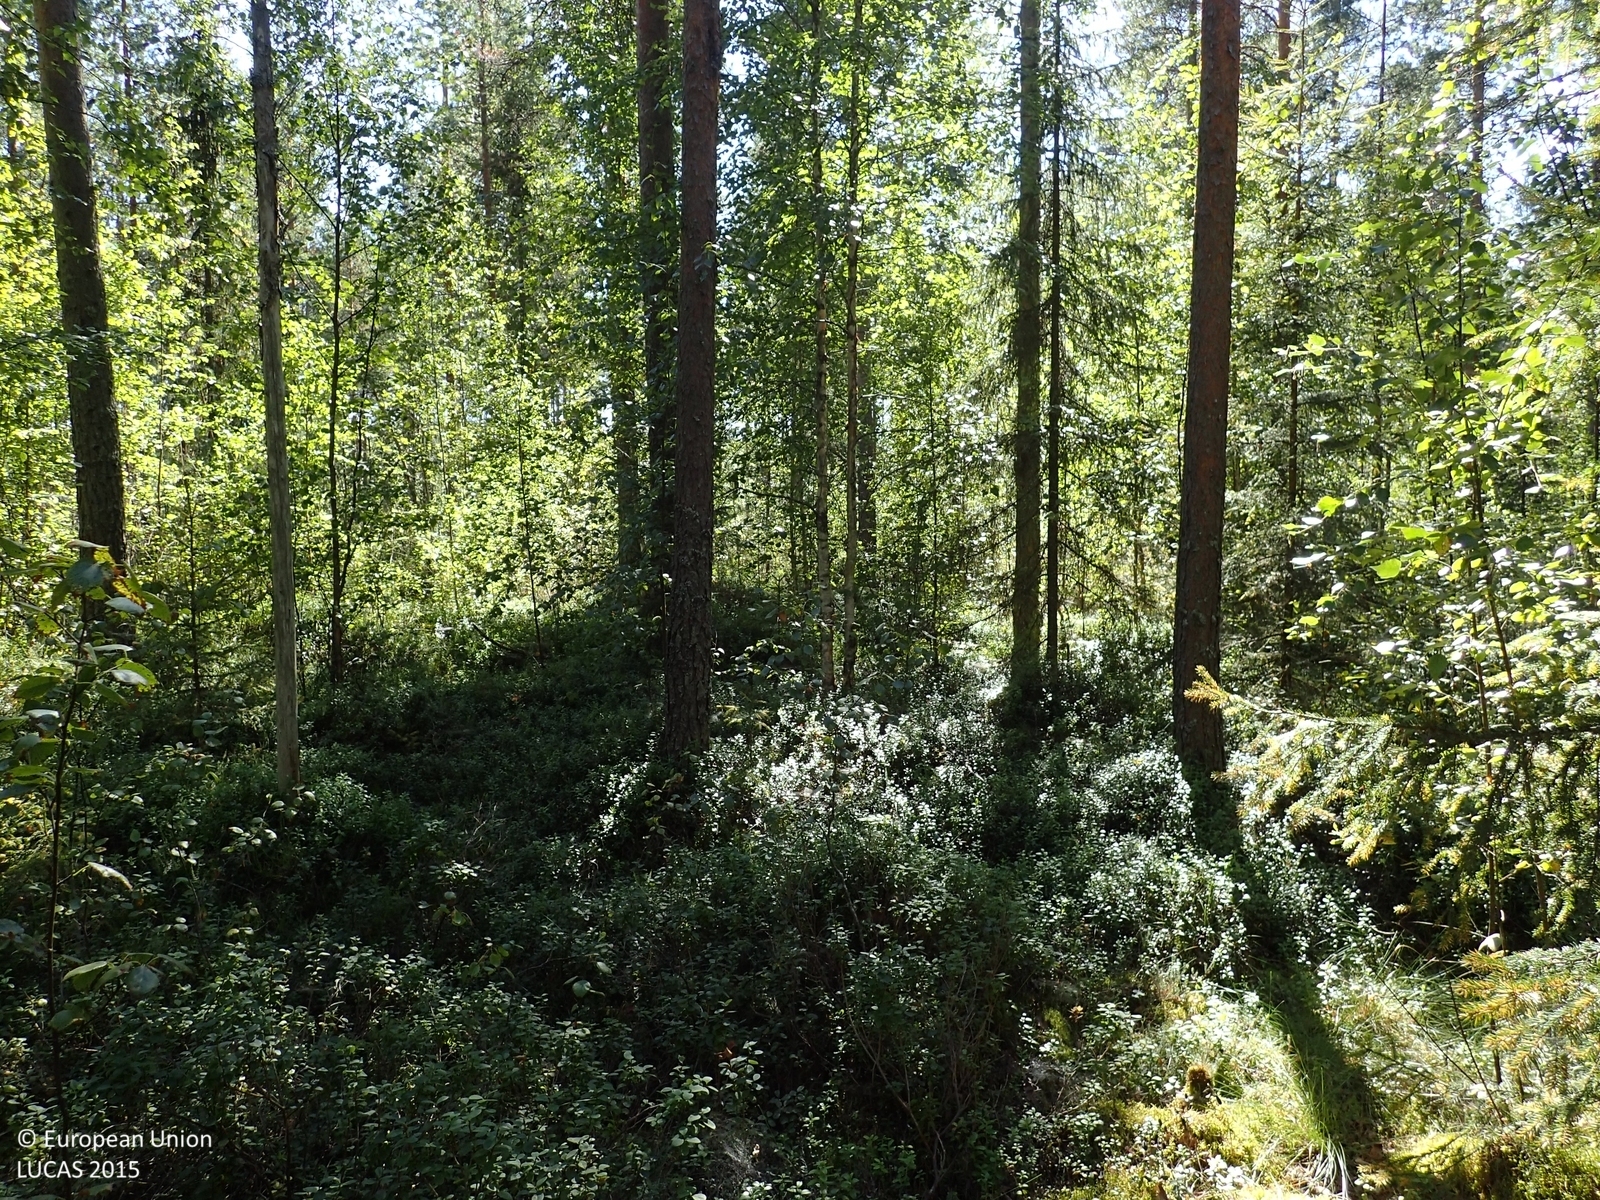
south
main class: Woodland
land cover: Other mixed woodland
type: boreal forest
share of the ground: > 75 %
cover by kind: coniferous forest trees 55 %, shrubs 25 %, broadleaved forest trees 20 %
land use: Forestry
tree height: > 5 m
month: August
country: FI
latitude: 62.5305
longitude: 22.4724
